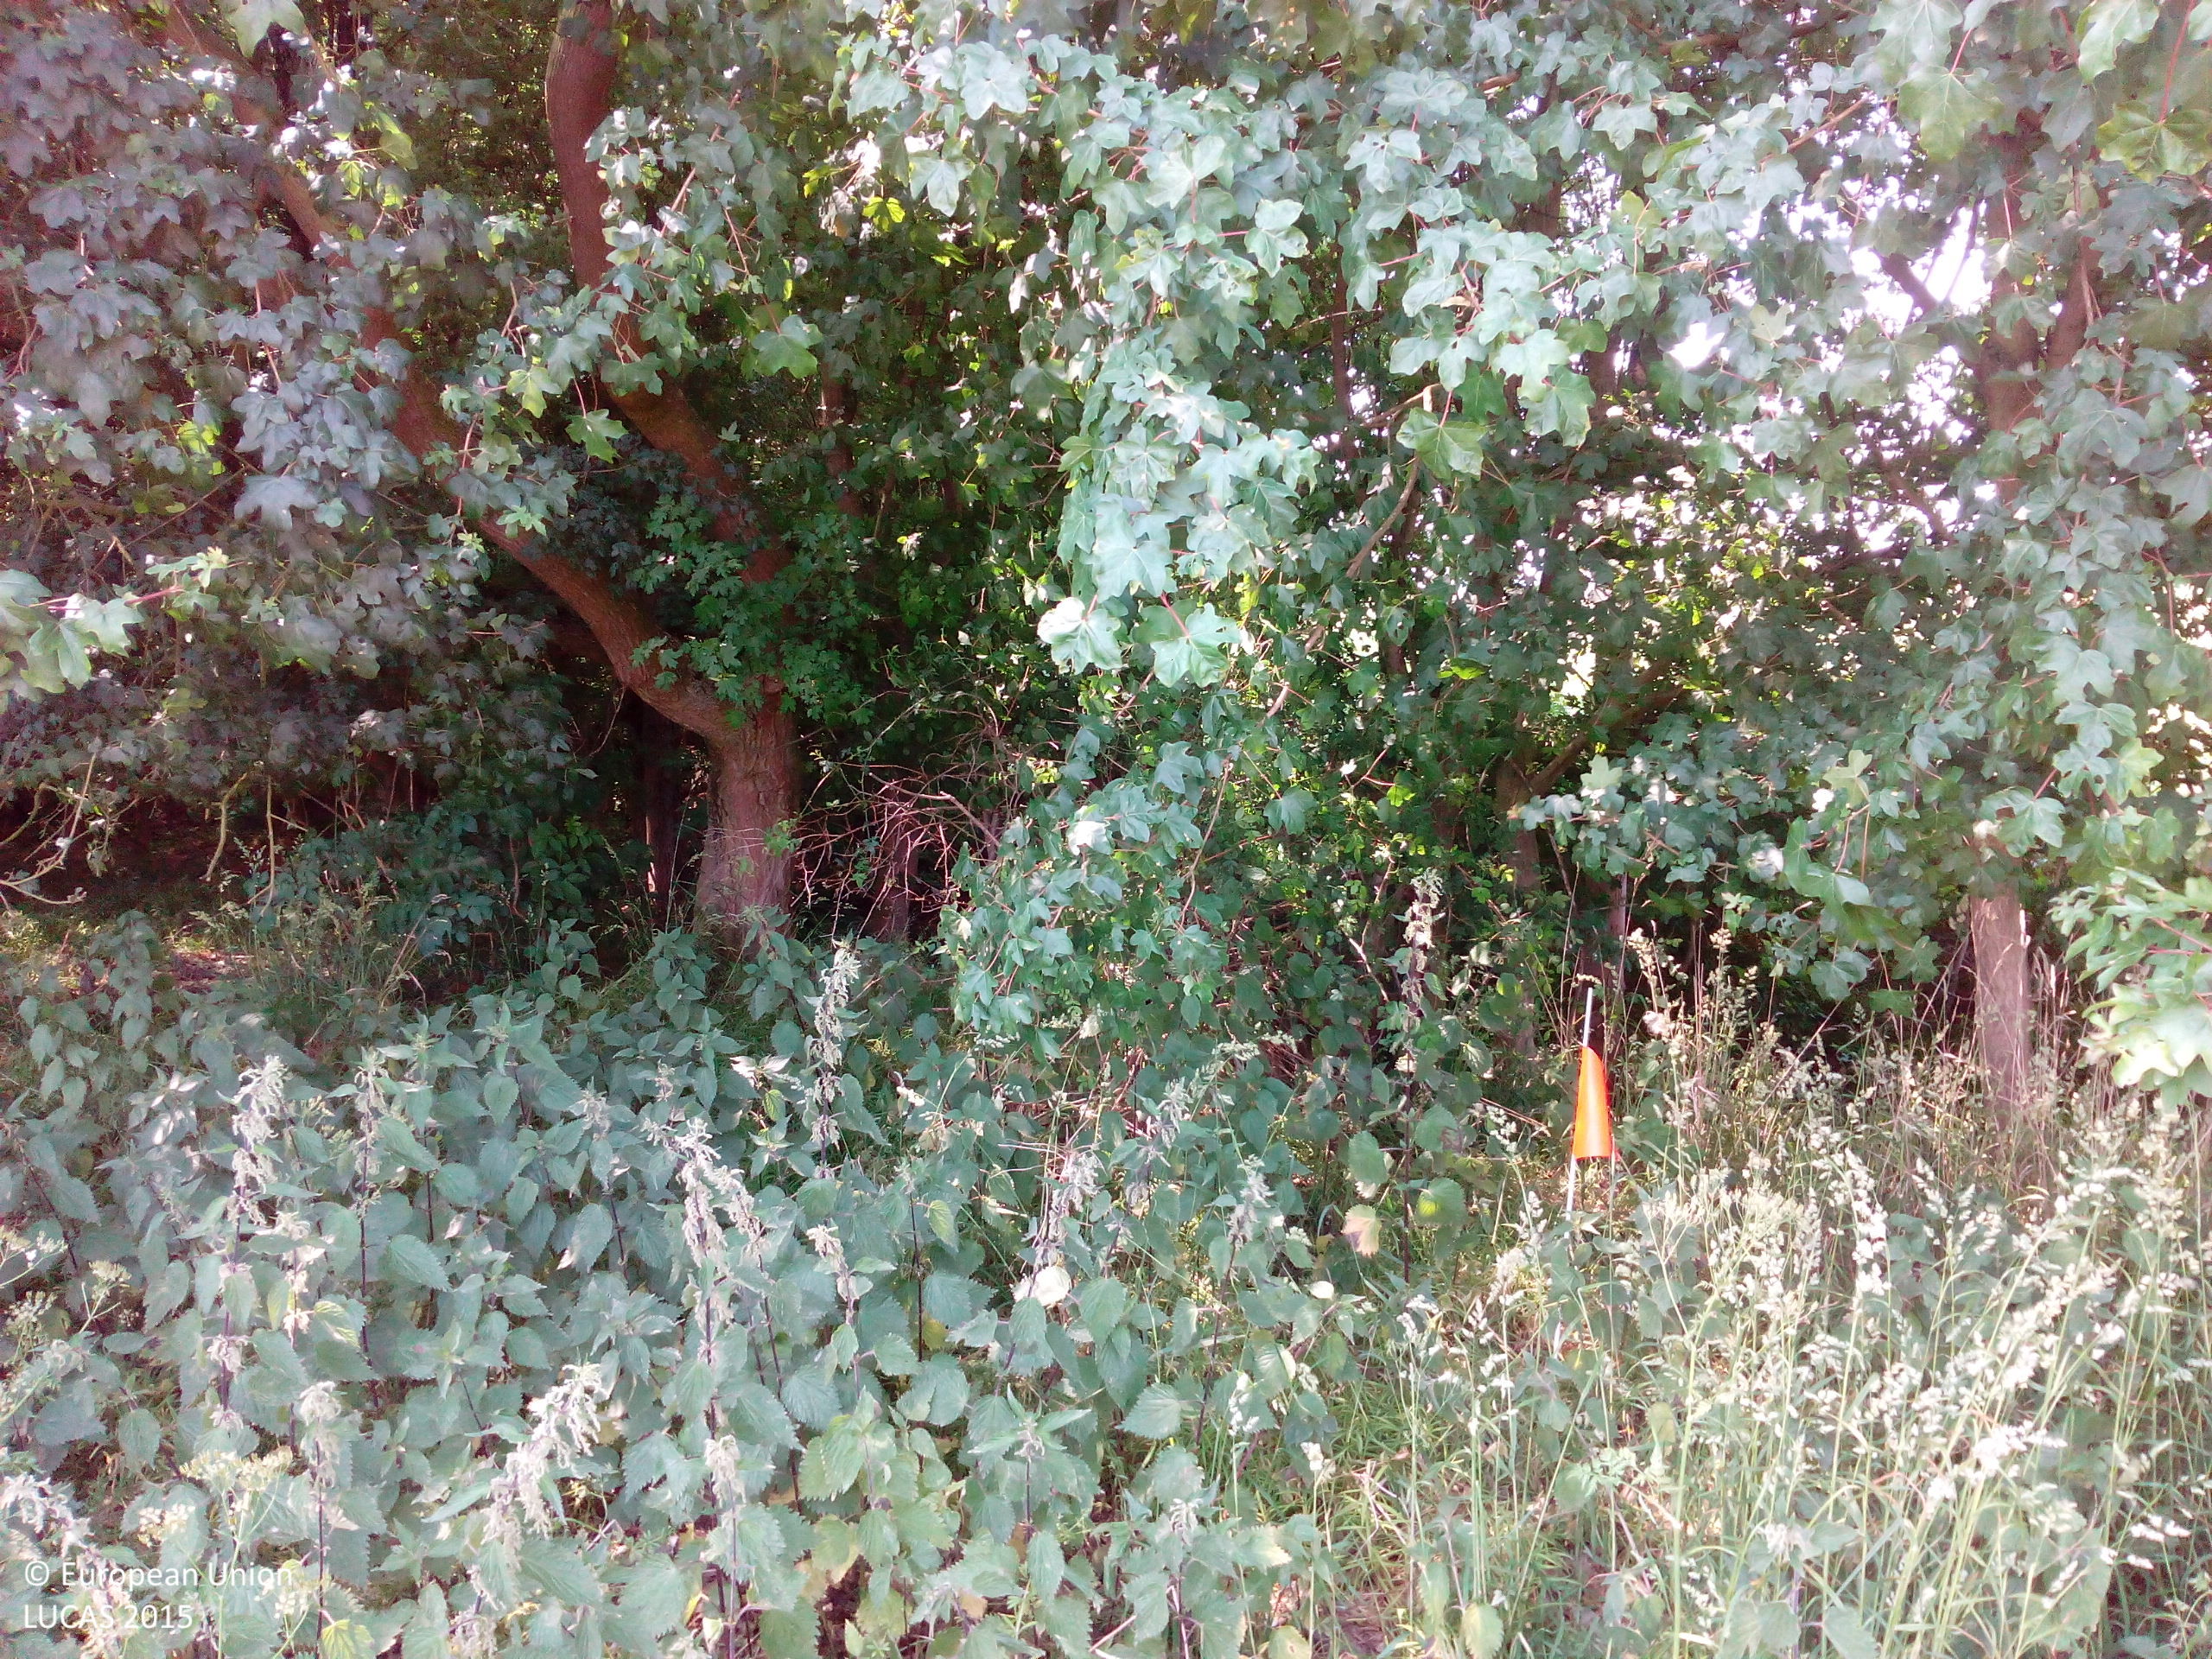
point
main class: Woodland
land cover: Broadleaved woodland
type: mesophytic deciduous forest
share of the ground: > 75 %
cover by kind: broadleaved forest trees 100 %
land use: Forestry
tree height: > 5 m
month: June
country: DE
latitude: 51.5253
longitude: 12.4356
